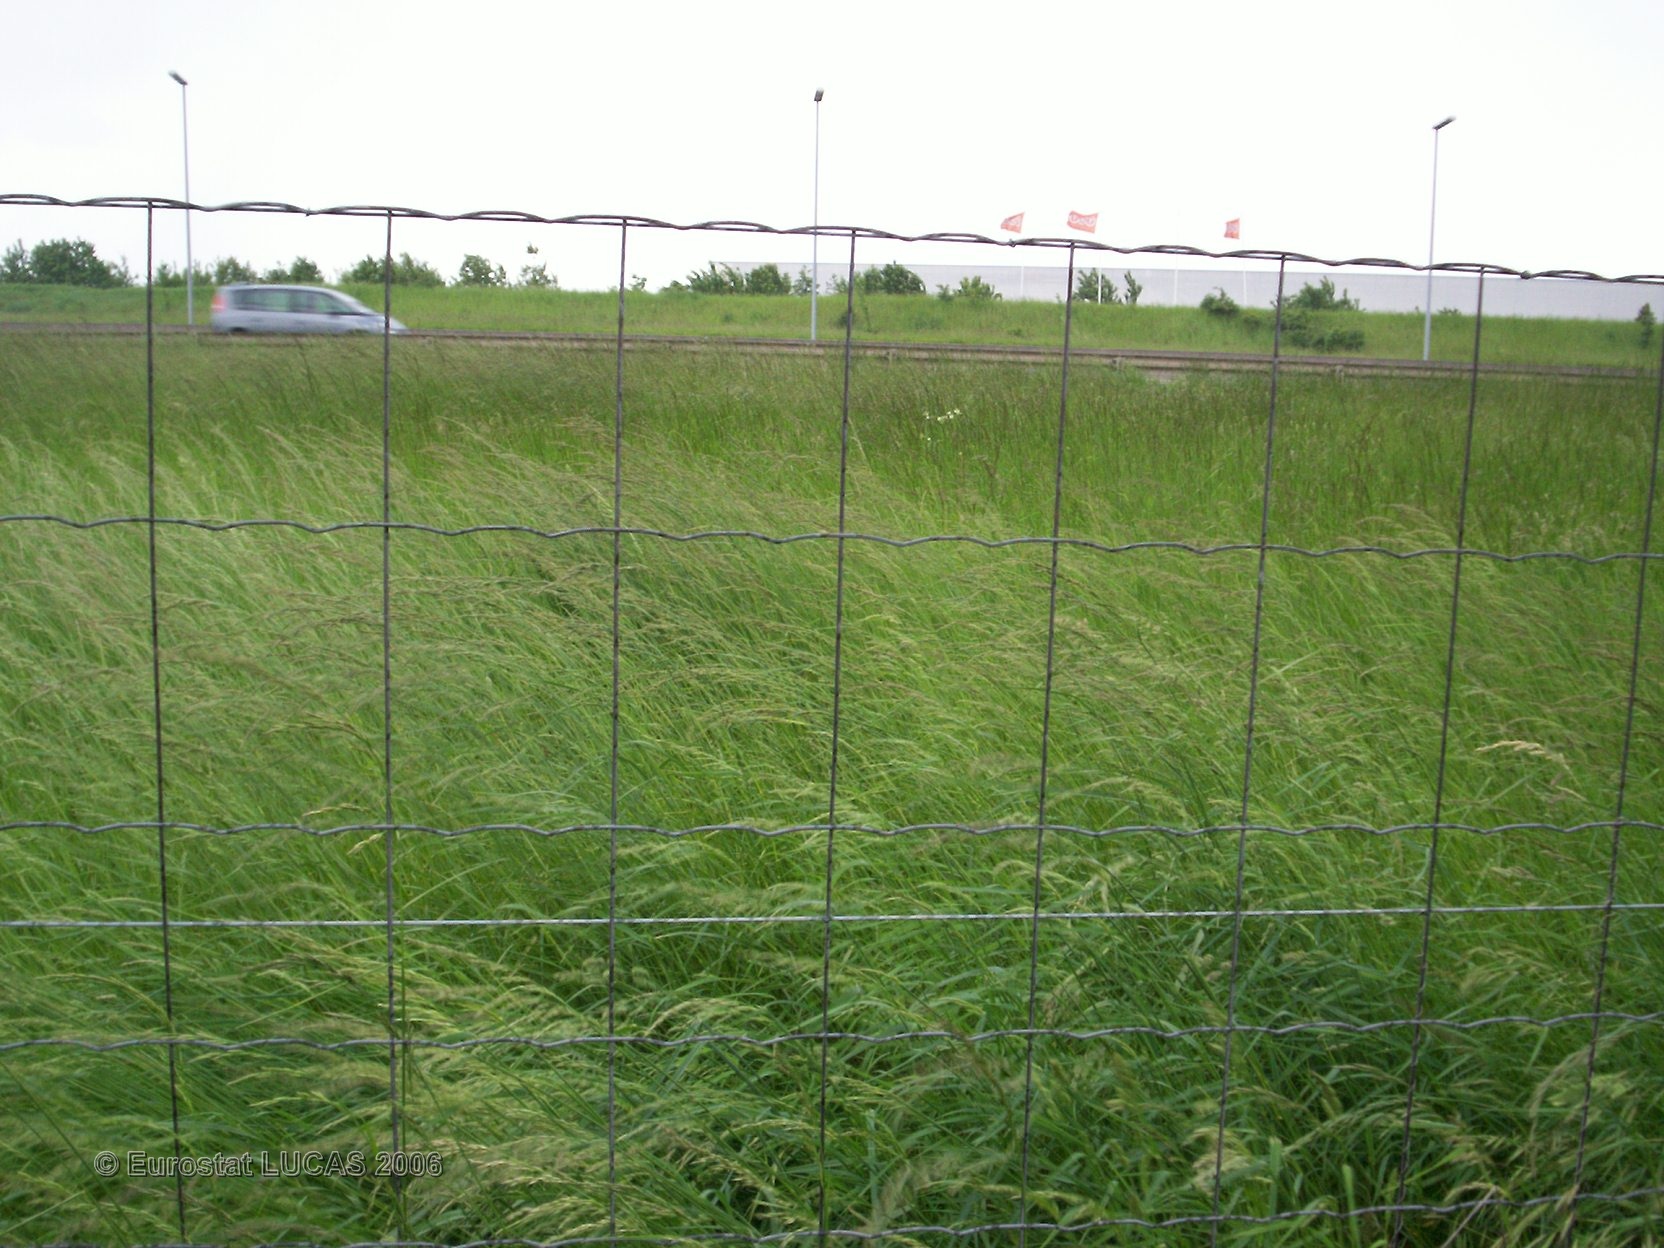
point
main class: Grassland
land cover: Grassland without tree/shrub cover
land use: Road transport
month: May
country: FR
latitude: 48.8305
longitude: 2.7018
